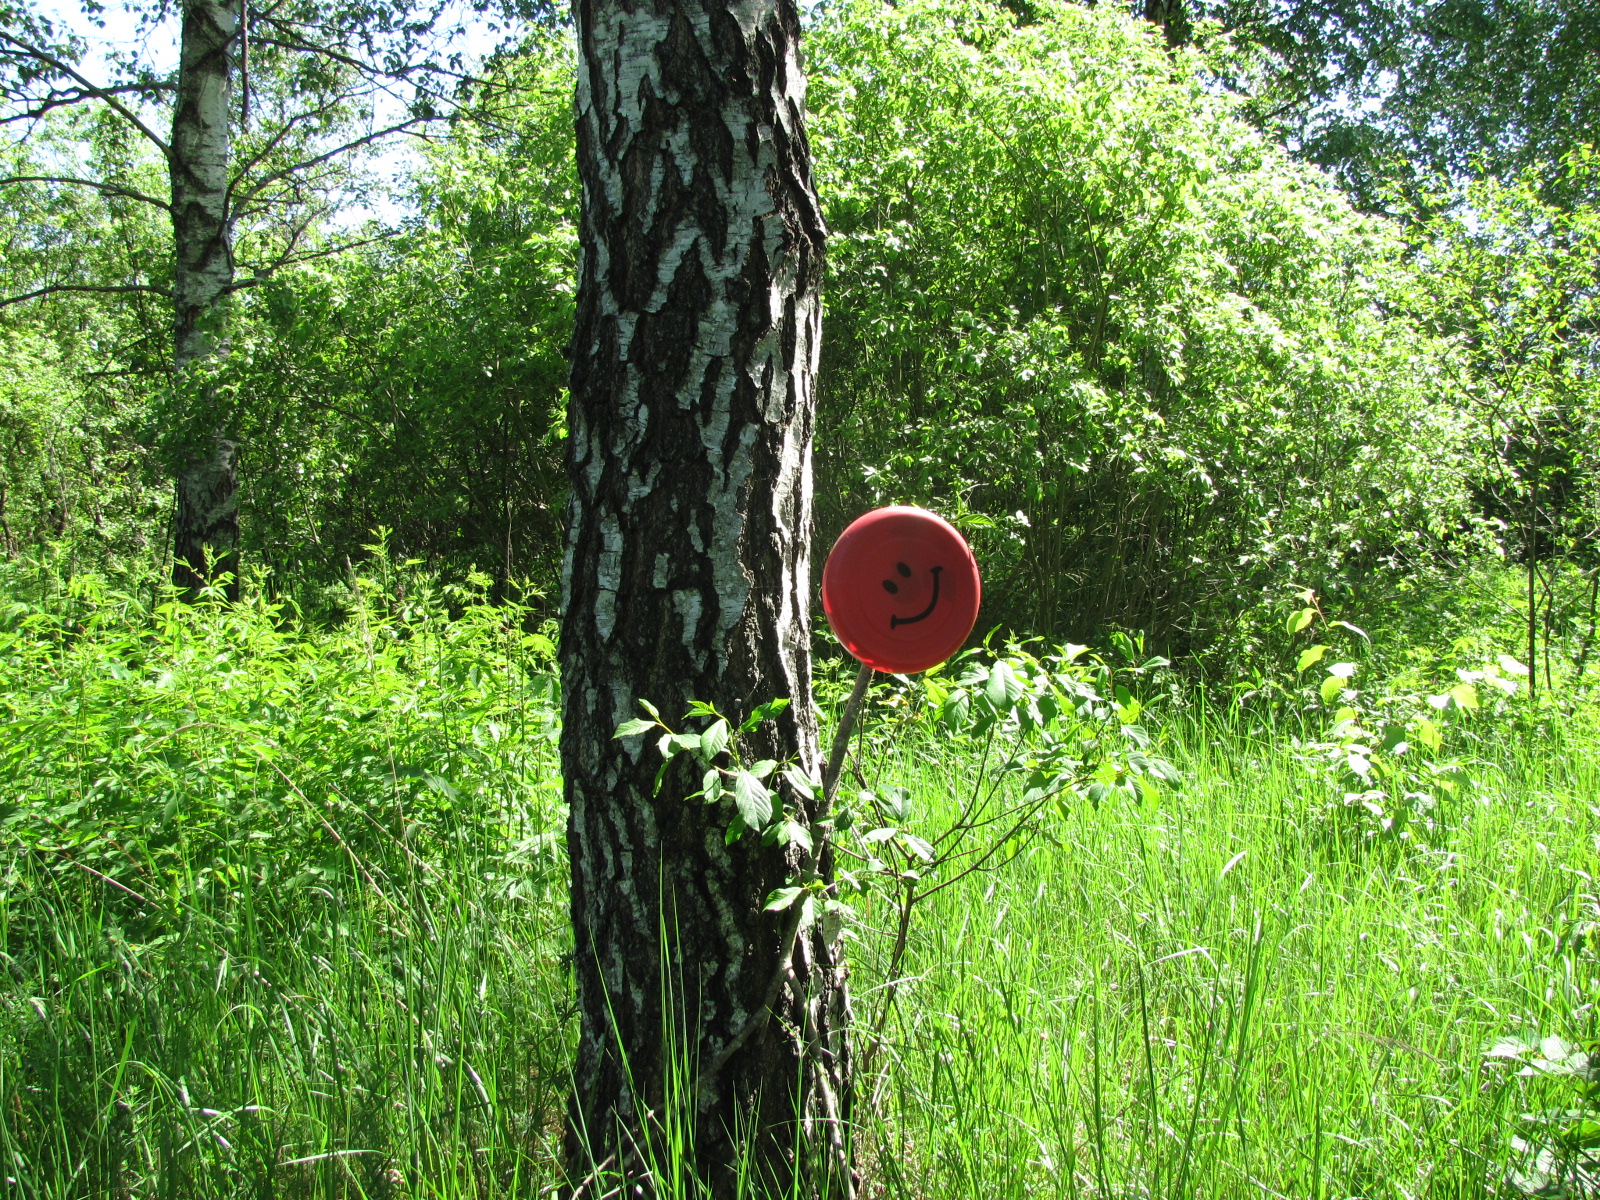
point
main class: Woodland
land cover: Broadleaved woodland
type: non-riverine alder, birch or aspen forest
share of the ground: > 75 %
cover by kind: broadleaved forest trees 80 %, herbaceous plants 20 %
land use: Semi-natural and natural areas not in use
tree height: > 5 m
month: June
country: LV
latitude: 56.5141
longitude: 24.3117
